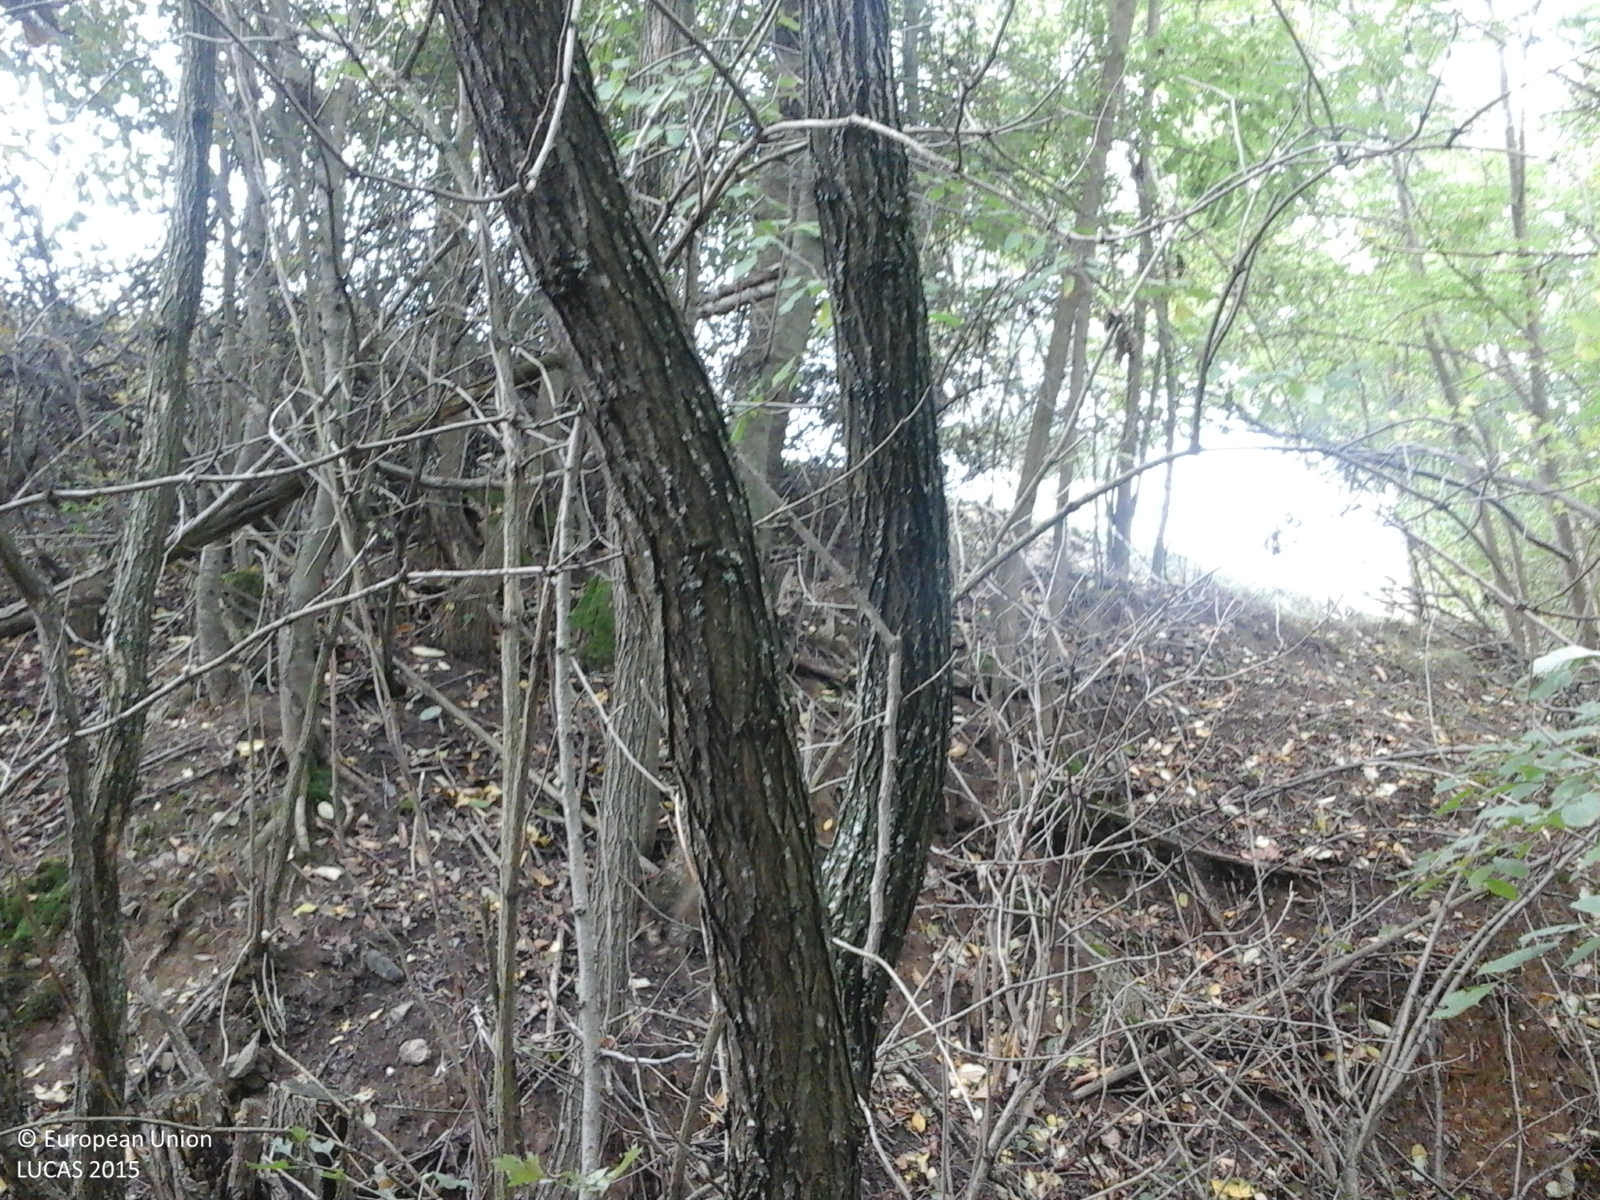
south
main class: Woodland
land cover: Broadleaved woodland
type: exotic forest
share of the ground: > 75 %
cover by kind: broadleaved forest trees 100 %
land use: Forestry
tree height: > 5 m
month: October
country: RO
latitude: 46.3917
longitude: 25.3323
